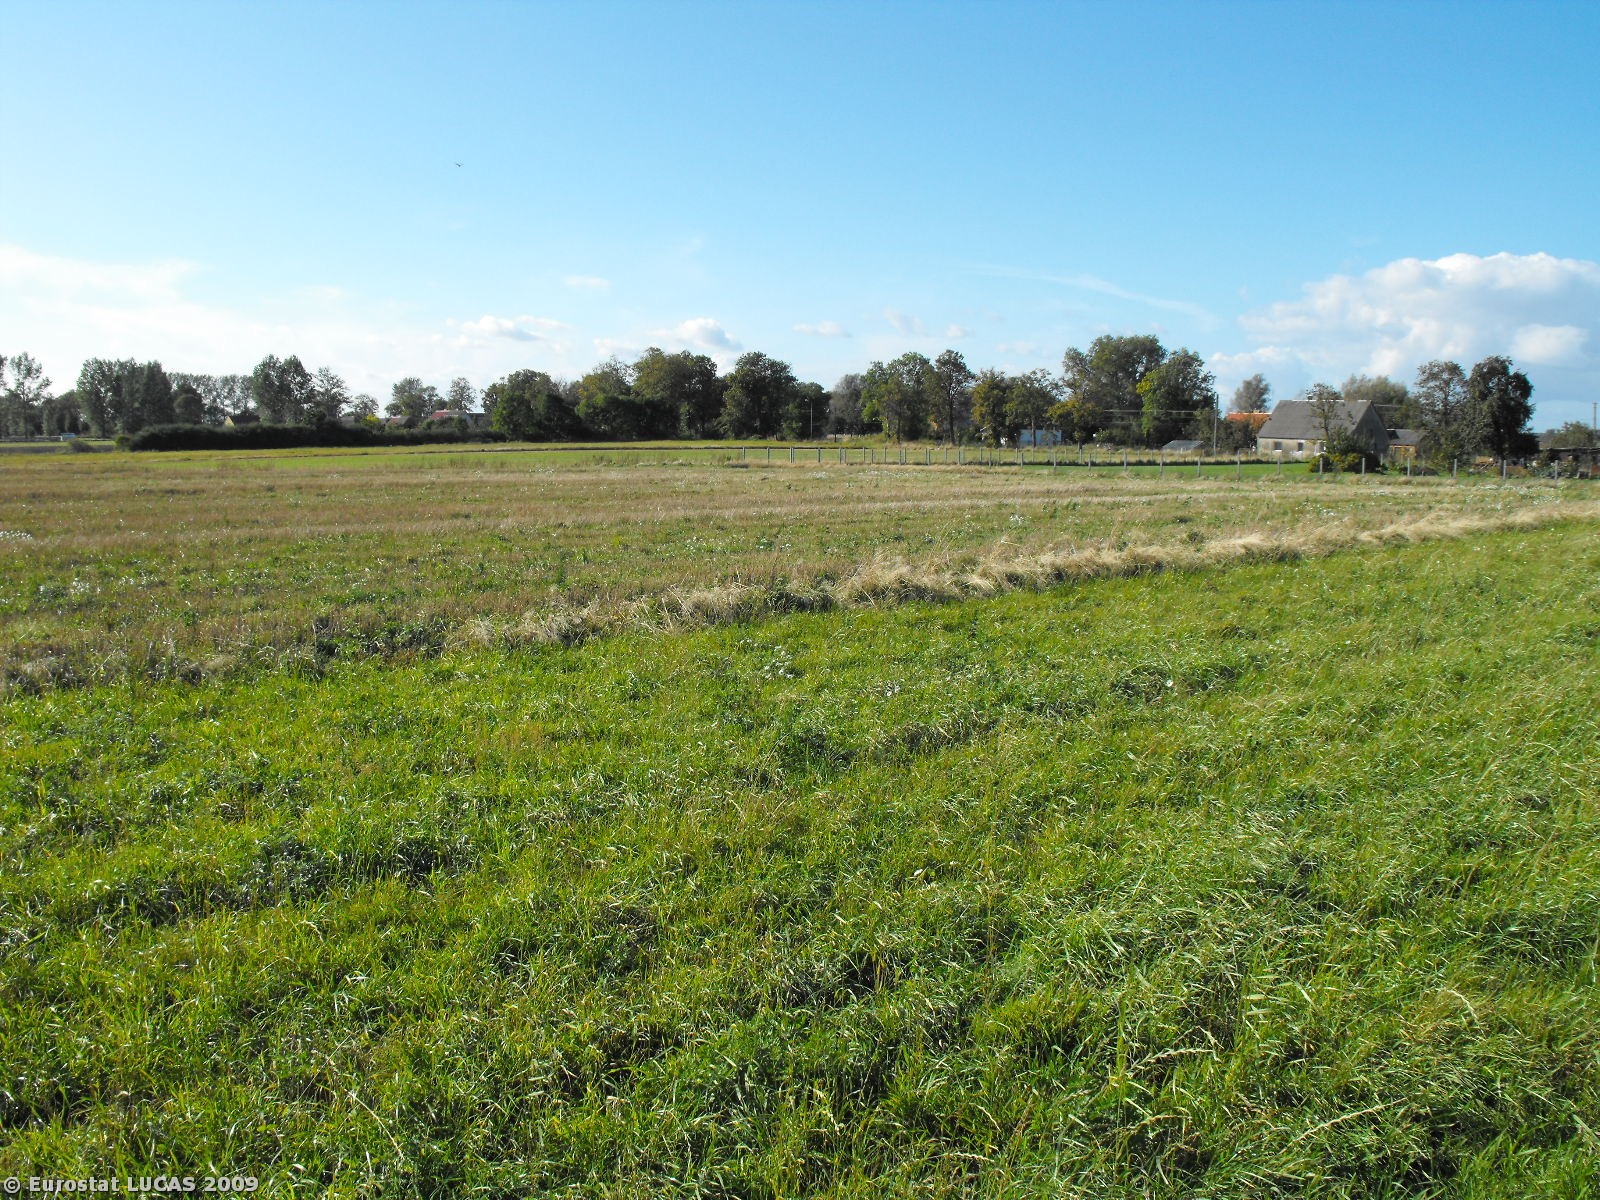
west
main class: Grassland
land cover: Grassland without tree/shrub cover
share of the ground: > 75 %
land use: Agriculture (excluding fallow land and kitchen gardens)
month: September
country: PL
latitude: 54.1281
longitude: 15.4044
